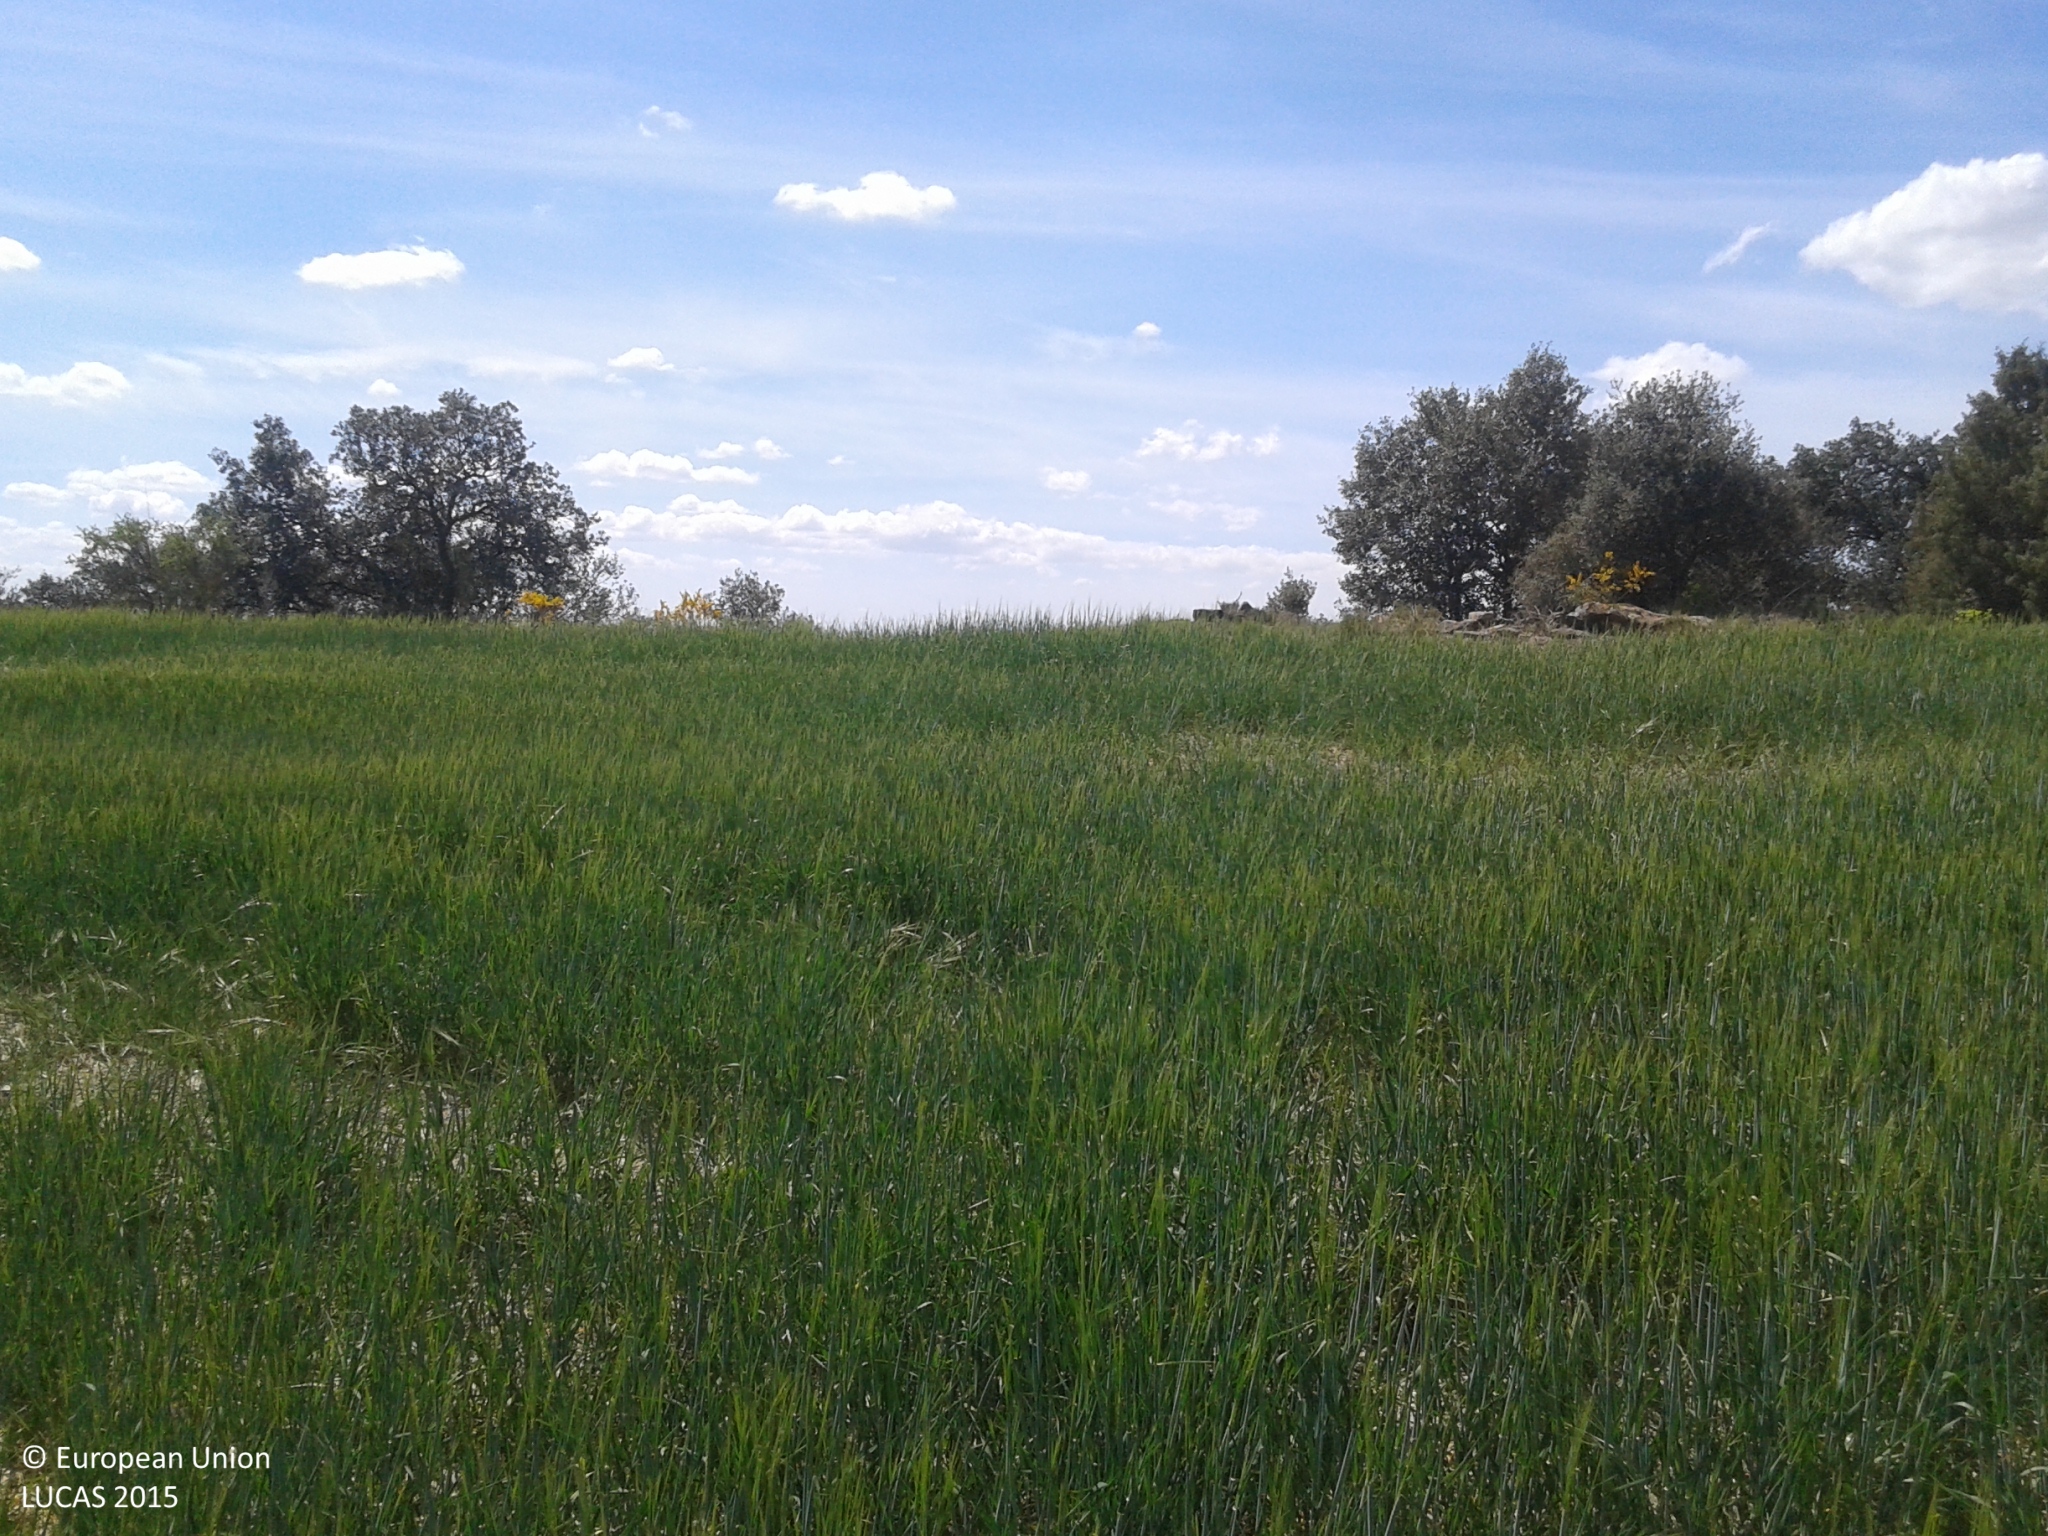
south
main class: Cropland
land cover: Barley
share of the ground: > 75 %
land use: Agriculture (excluding fallow land and kitchen gardens)
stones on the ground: 10 - 25 %
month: April
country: ES
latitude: 41.8291
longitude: 1.1384
